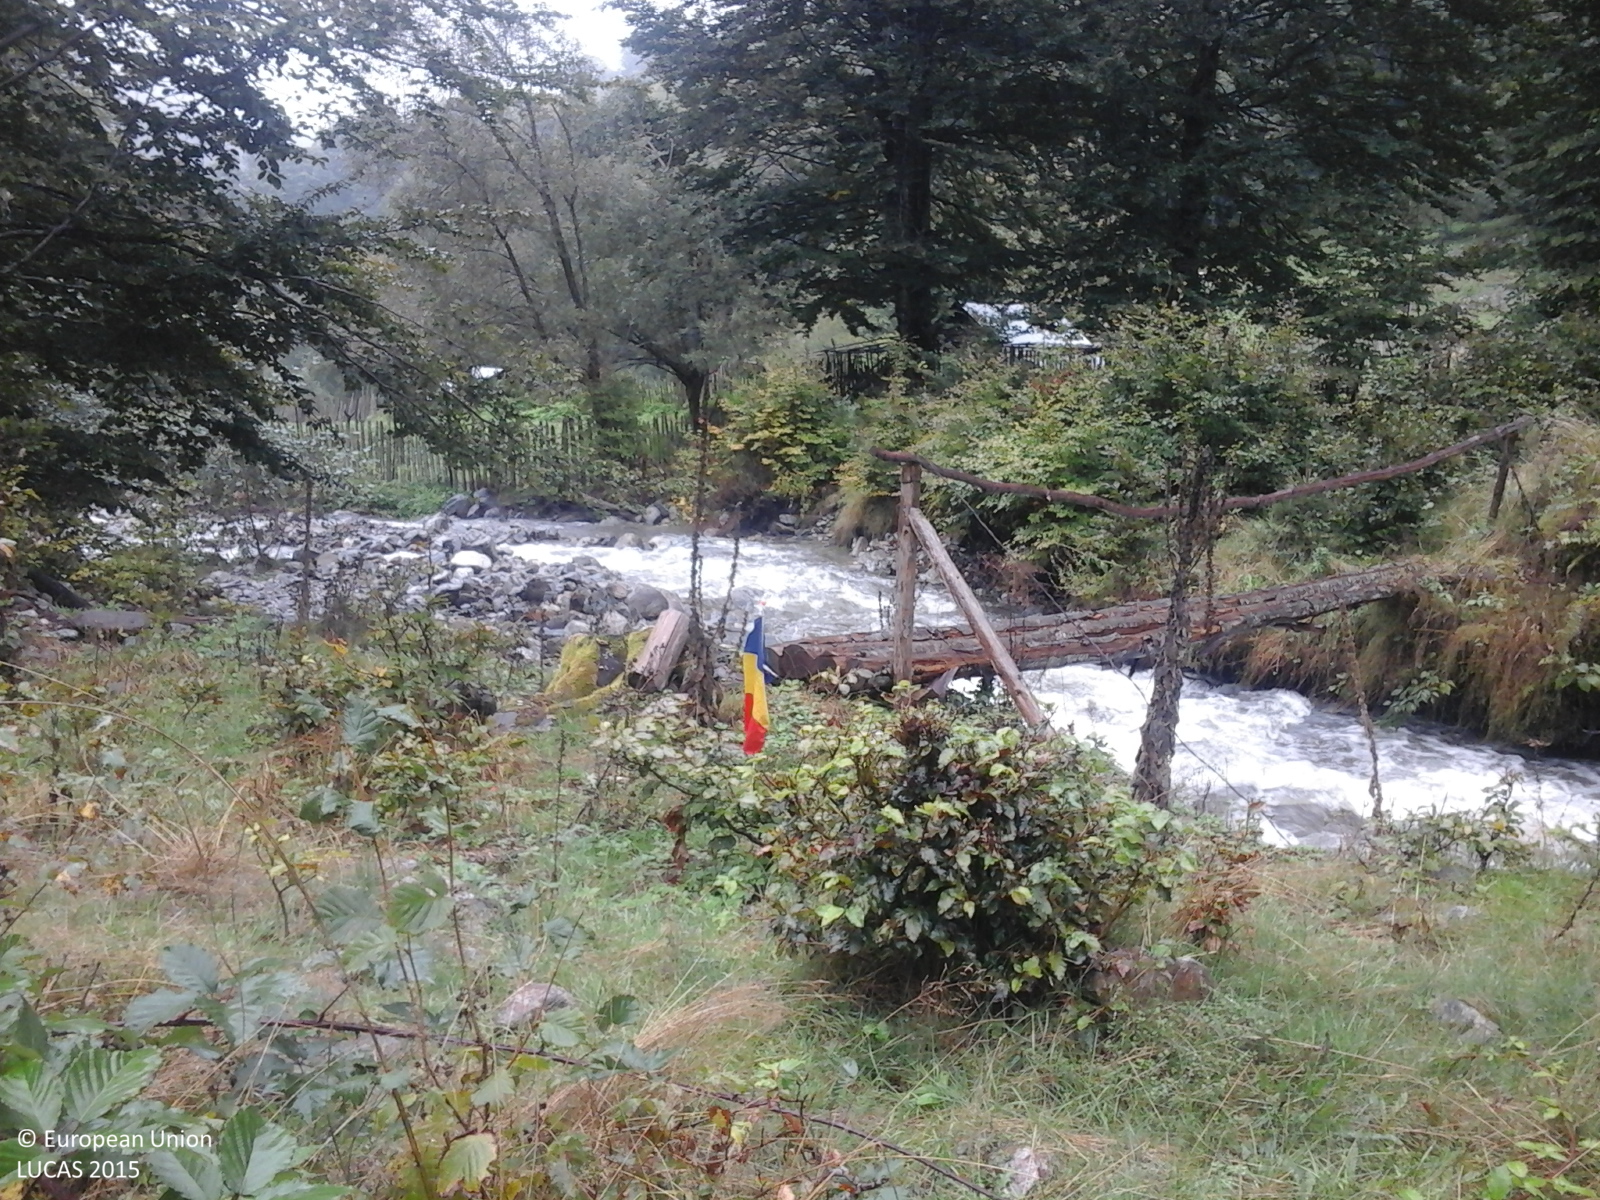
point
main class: Shrubland
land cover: Shrubland with sparse tree cover
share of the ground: > 75 %
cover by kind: herbaceous plants 55 %, shrubs 40 %, broadleaved forest trees 5 %
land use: Forestry
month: September
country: RO
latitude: 45.3526
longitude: 23.9946
